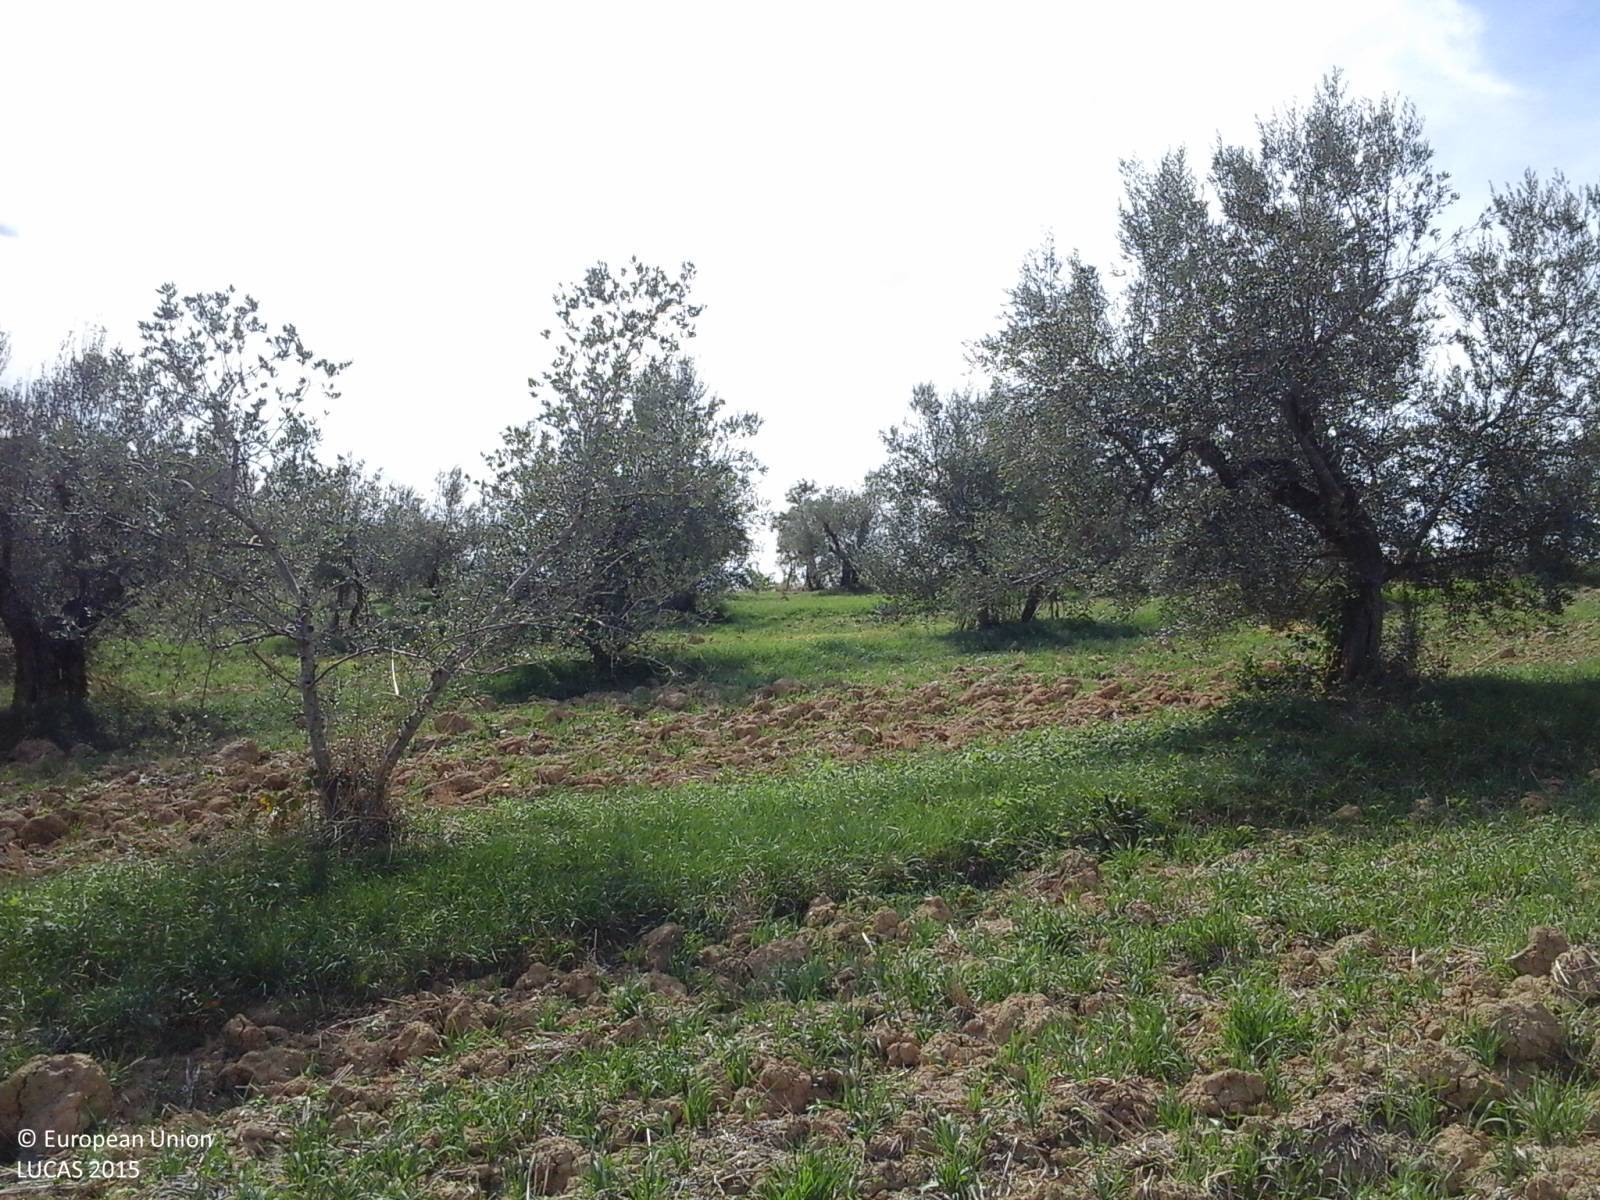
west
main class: Cropland
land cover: Olive groves
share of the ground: 10 - 25 %
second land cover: Other bare soil
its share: > 75 %
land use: Agriculture (excluding fallow land and kitchen gardens)
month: September
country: IT
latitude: 43.0239
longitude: 12.3614
